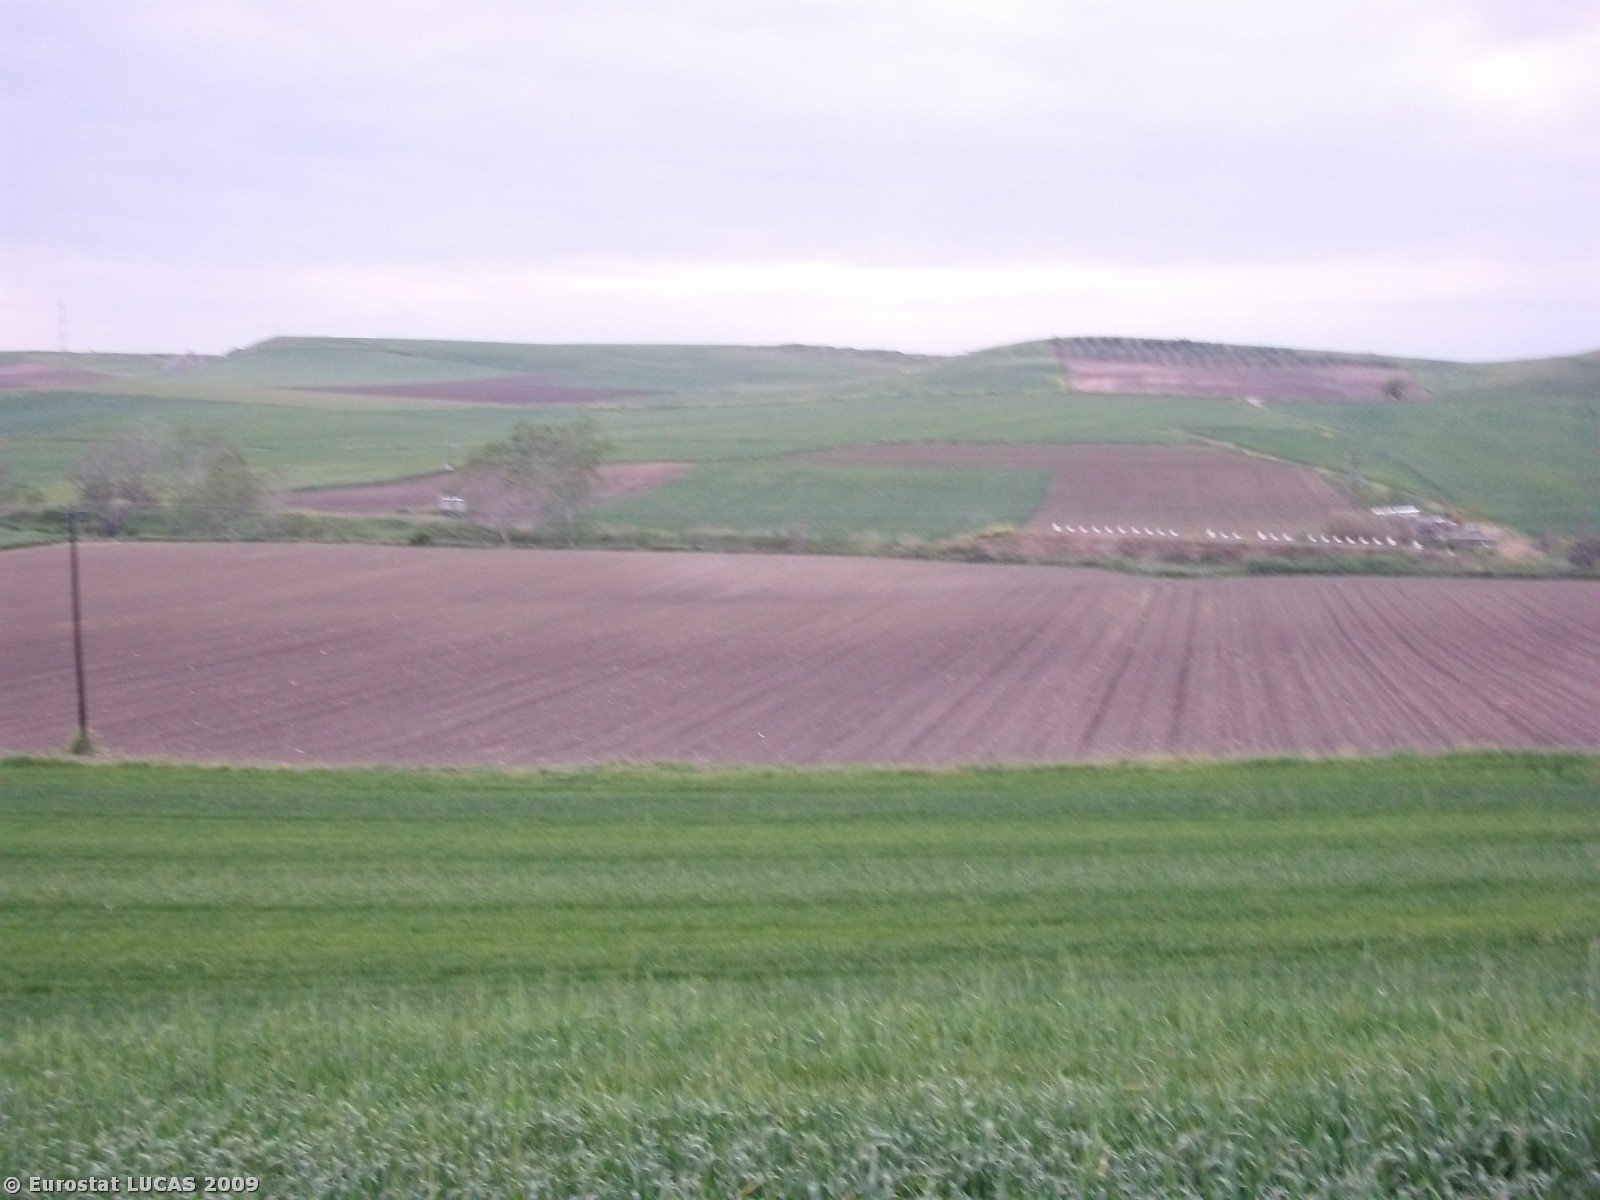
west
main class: Cropland
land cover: Common wheat
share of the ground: > 75 %
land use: Agriculture (excluding fallow land and kitchen gardens)
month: April
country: GR
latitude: 39.5202
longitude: 22.4938
